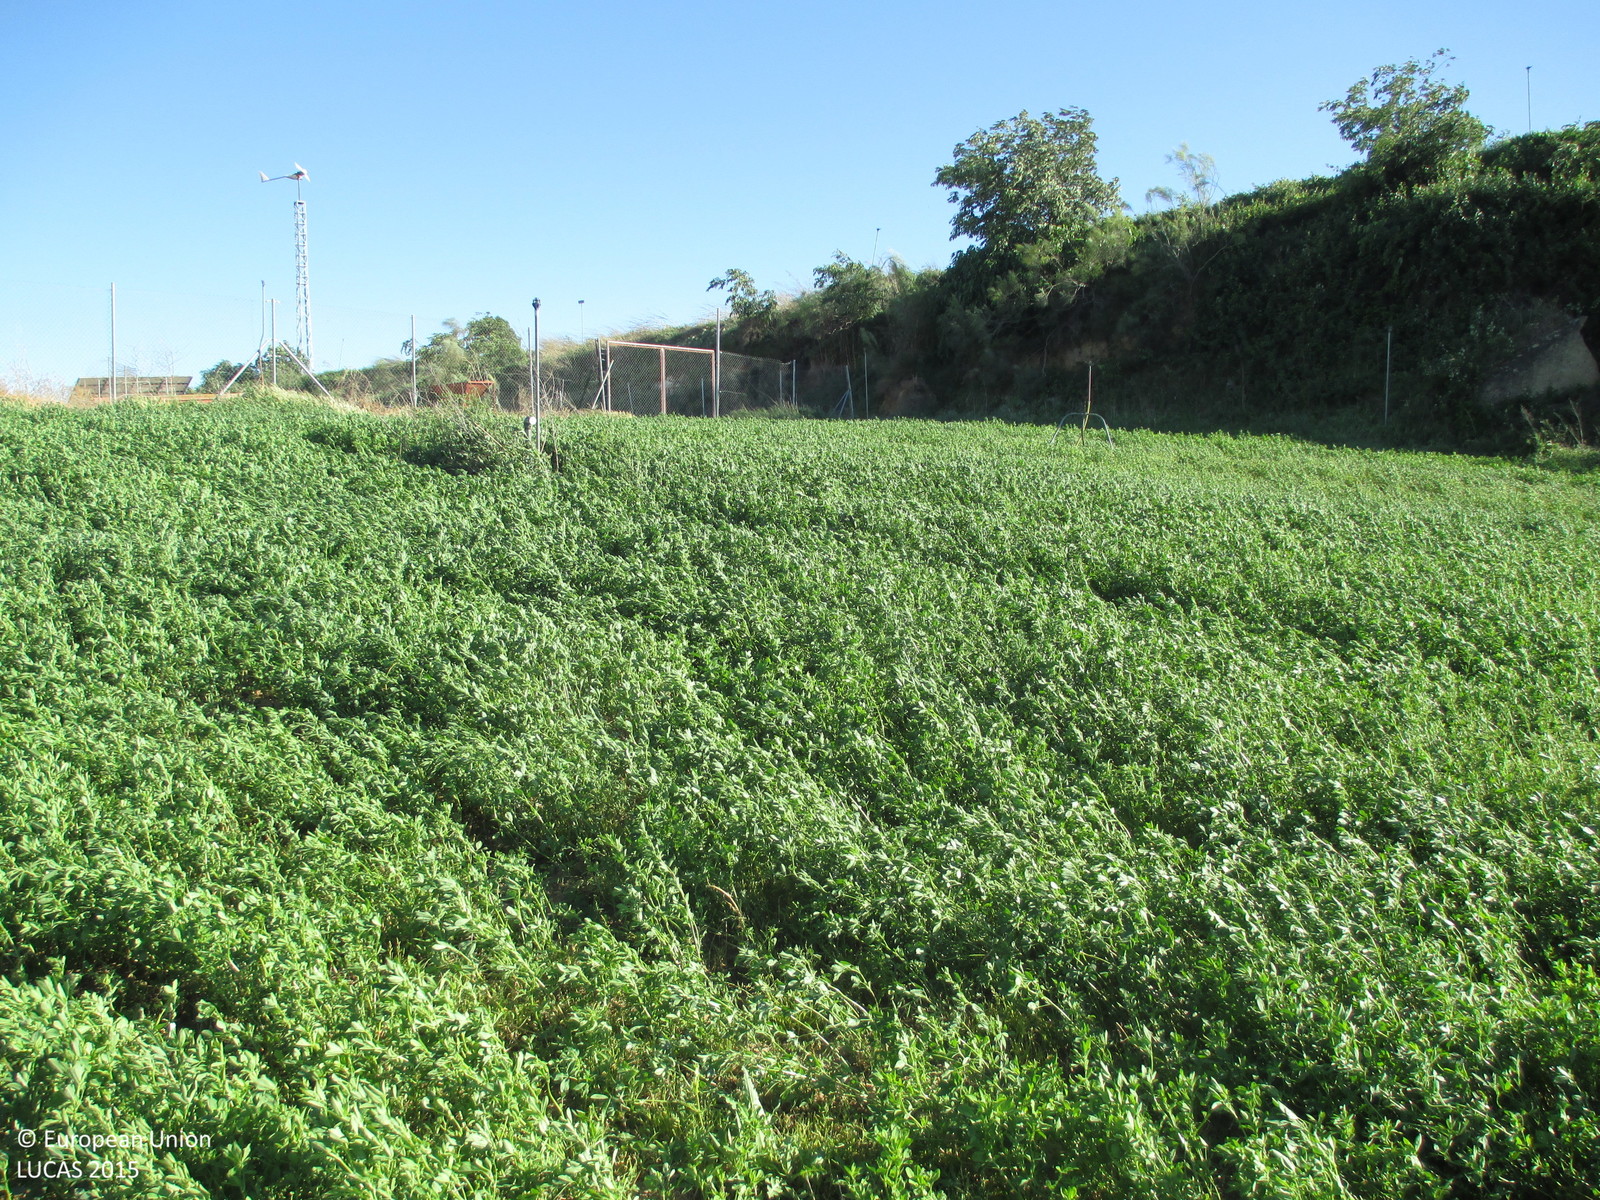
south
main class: Cropland
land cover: Lucerne
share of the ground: > 75 %
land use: Agriculture (excluding fallow land and kitchen gardens)
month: May
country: ES
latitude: 41.9965
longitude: 0.0219
